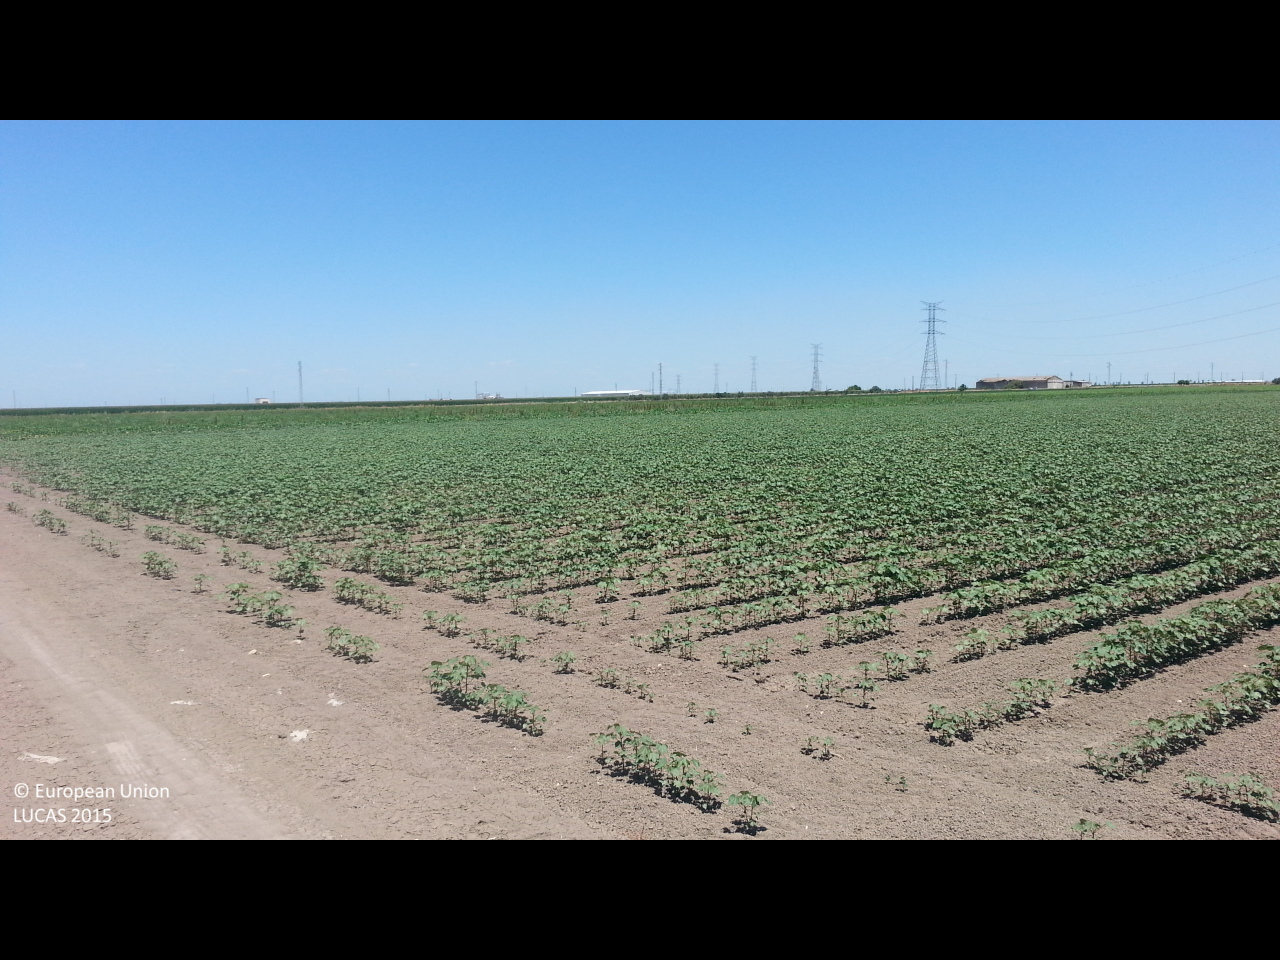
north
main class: Cropland
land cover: Maize
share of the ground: > 75 %
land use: Agriculture (excluding fallow land and kitchen gardens)
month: June
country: ES
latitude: 36.9835
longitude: -6.0485
